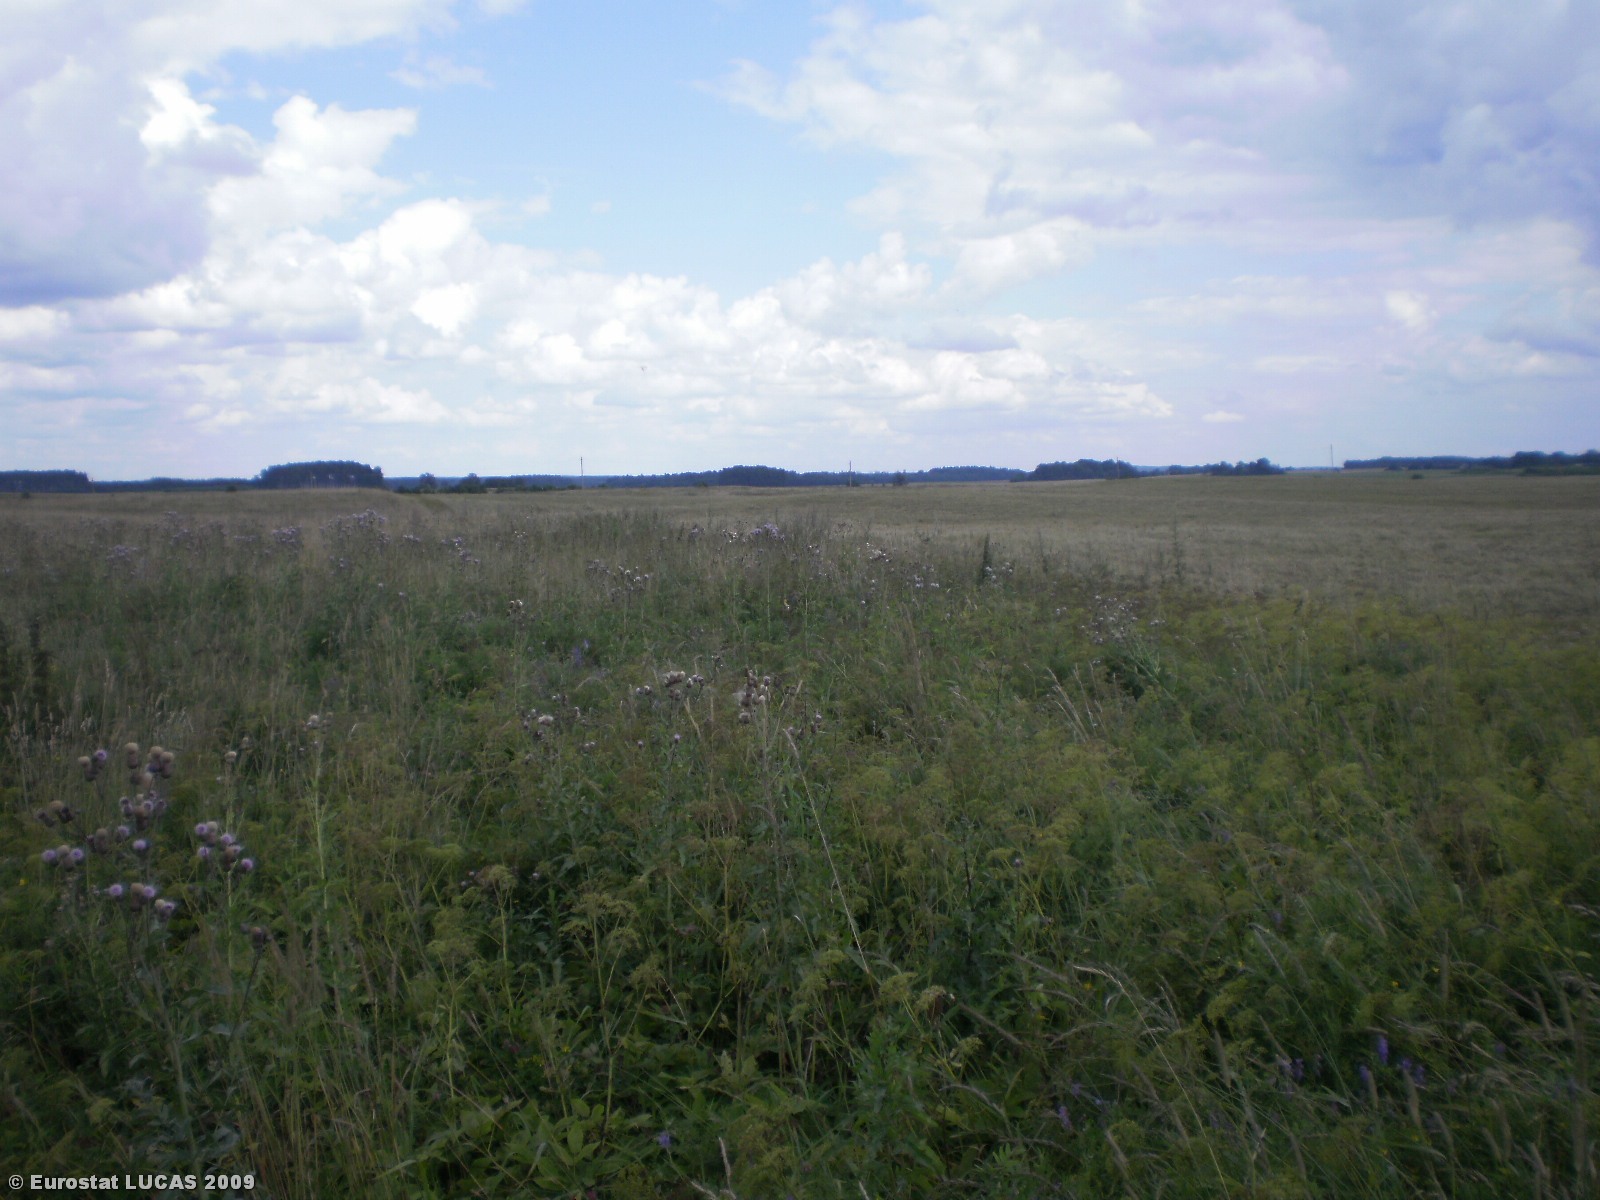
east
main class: Grassland
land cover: Grassland without tree/shrub cover
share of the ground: > 75 %
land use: Agriculture (excluding fallow land and kitchen gardens)
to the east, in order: Grassland without tree/shrub cover
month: July
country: LT
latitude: 55.9282
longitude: 25.7009
